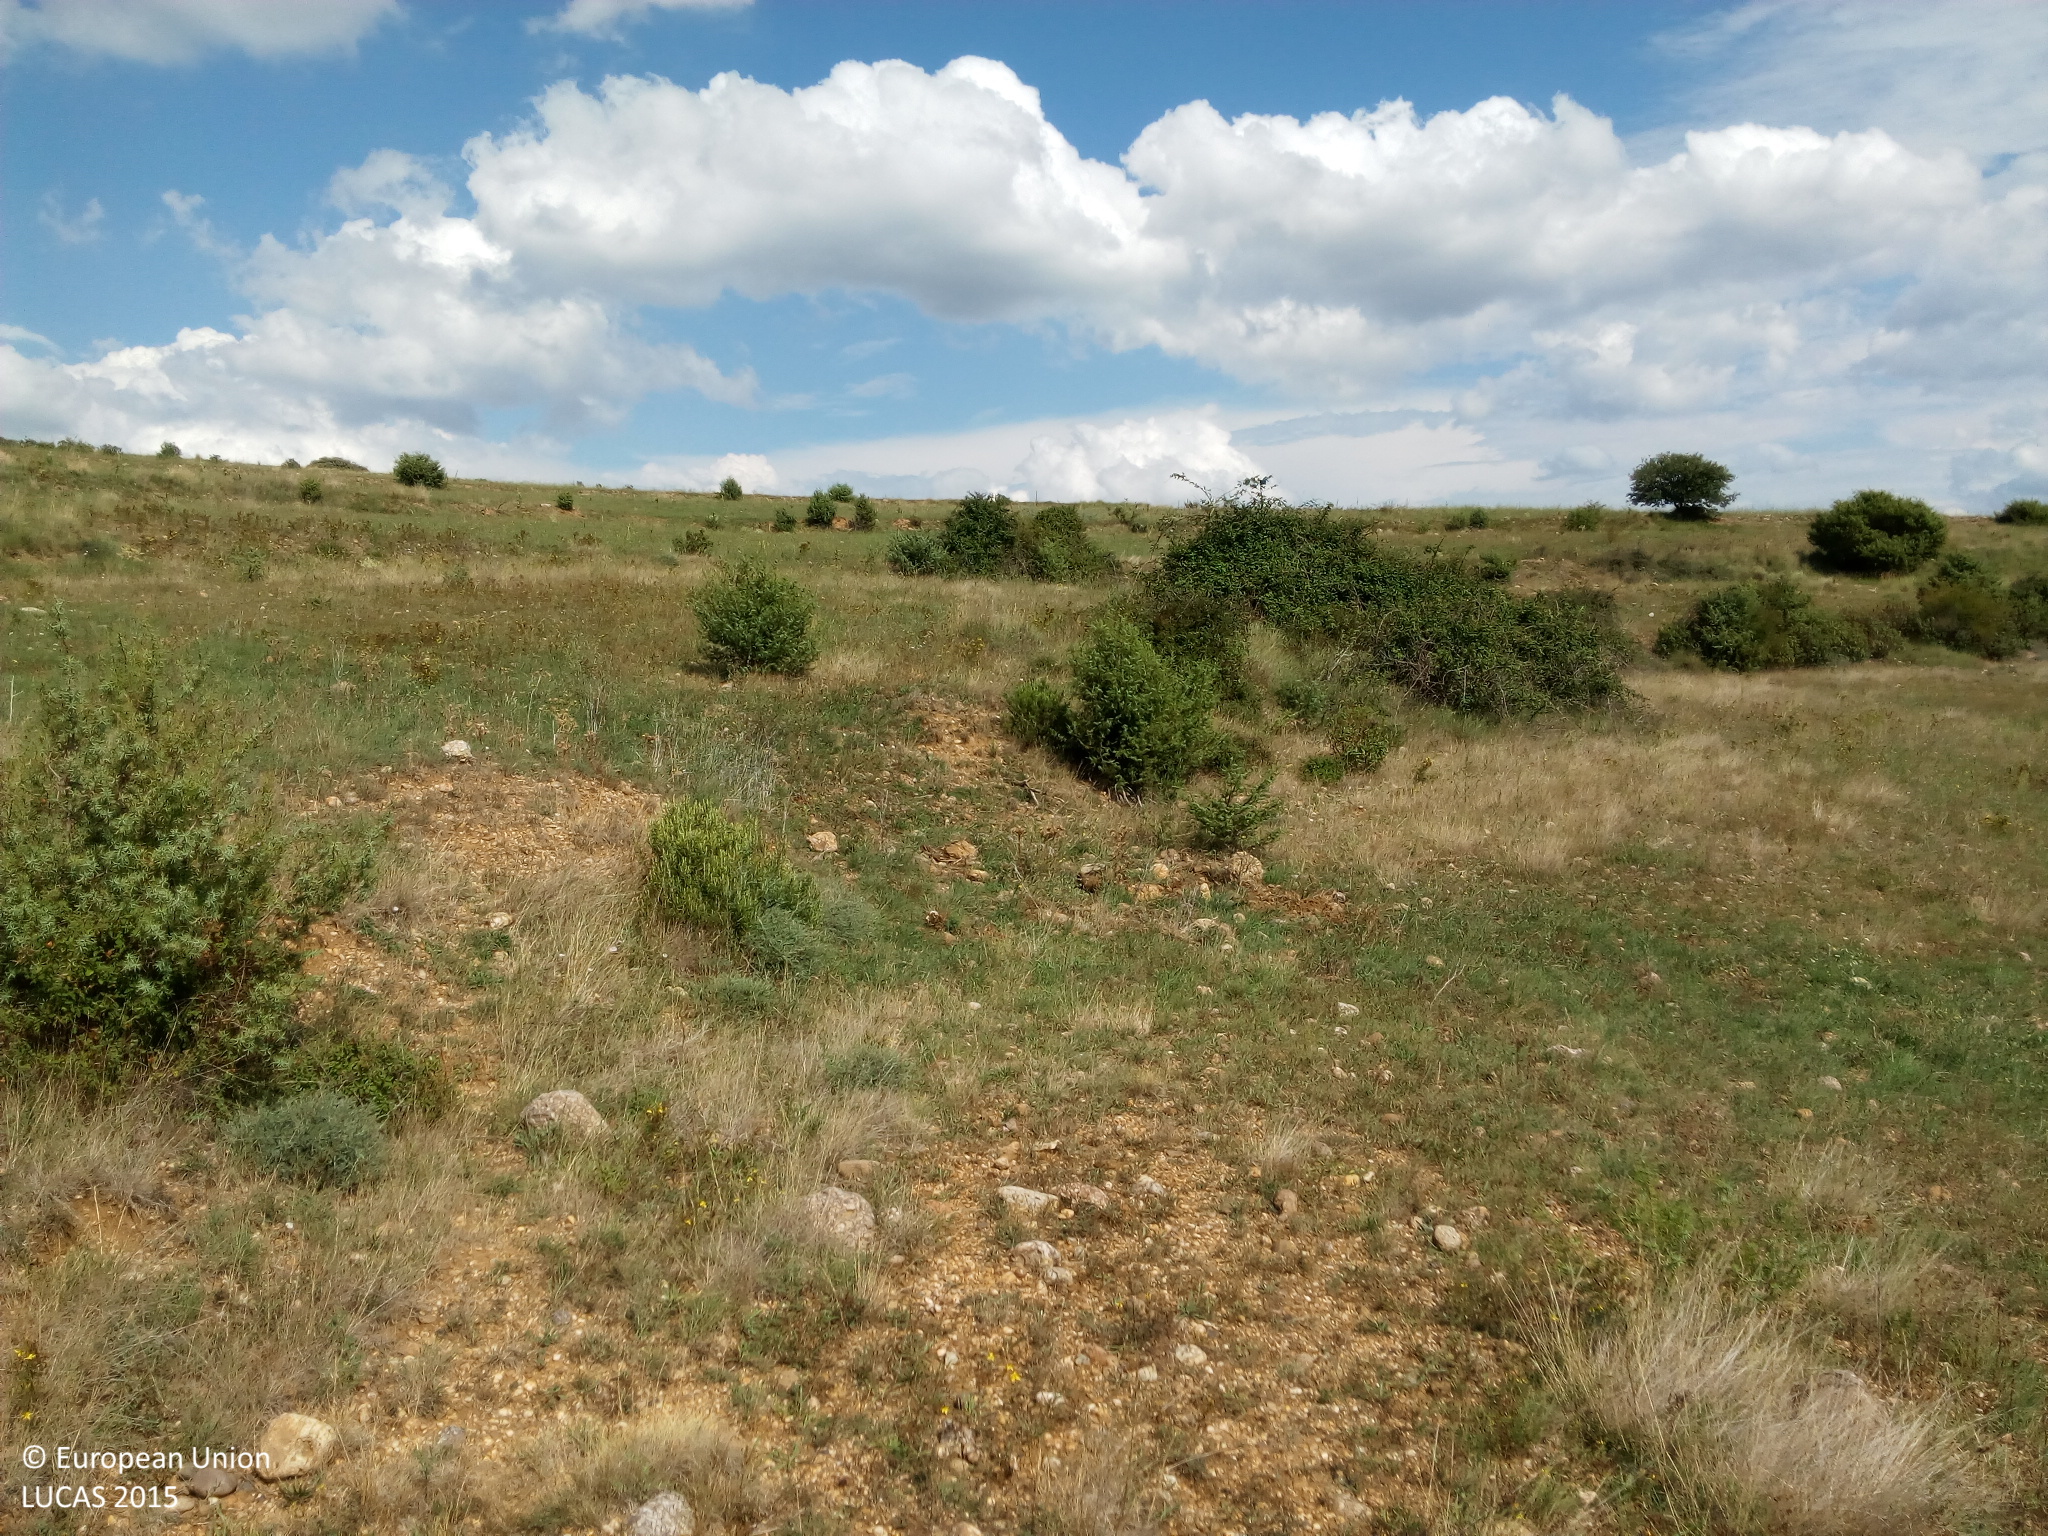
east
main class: Grassland
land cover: Grassland without tree/shrub cover
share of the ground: > 75 %
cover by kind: unconsolidated bare surface 60 %, herbaceous plants 40 %
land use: Semi-natural and natural areas not in use
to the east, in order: Grassland without tree/shrub cover; Grass margins; Grassland without tree/shrub cover; Fences; Broadleaved woodland
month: August
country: ES
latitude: 42.1550
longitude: 0.5312
